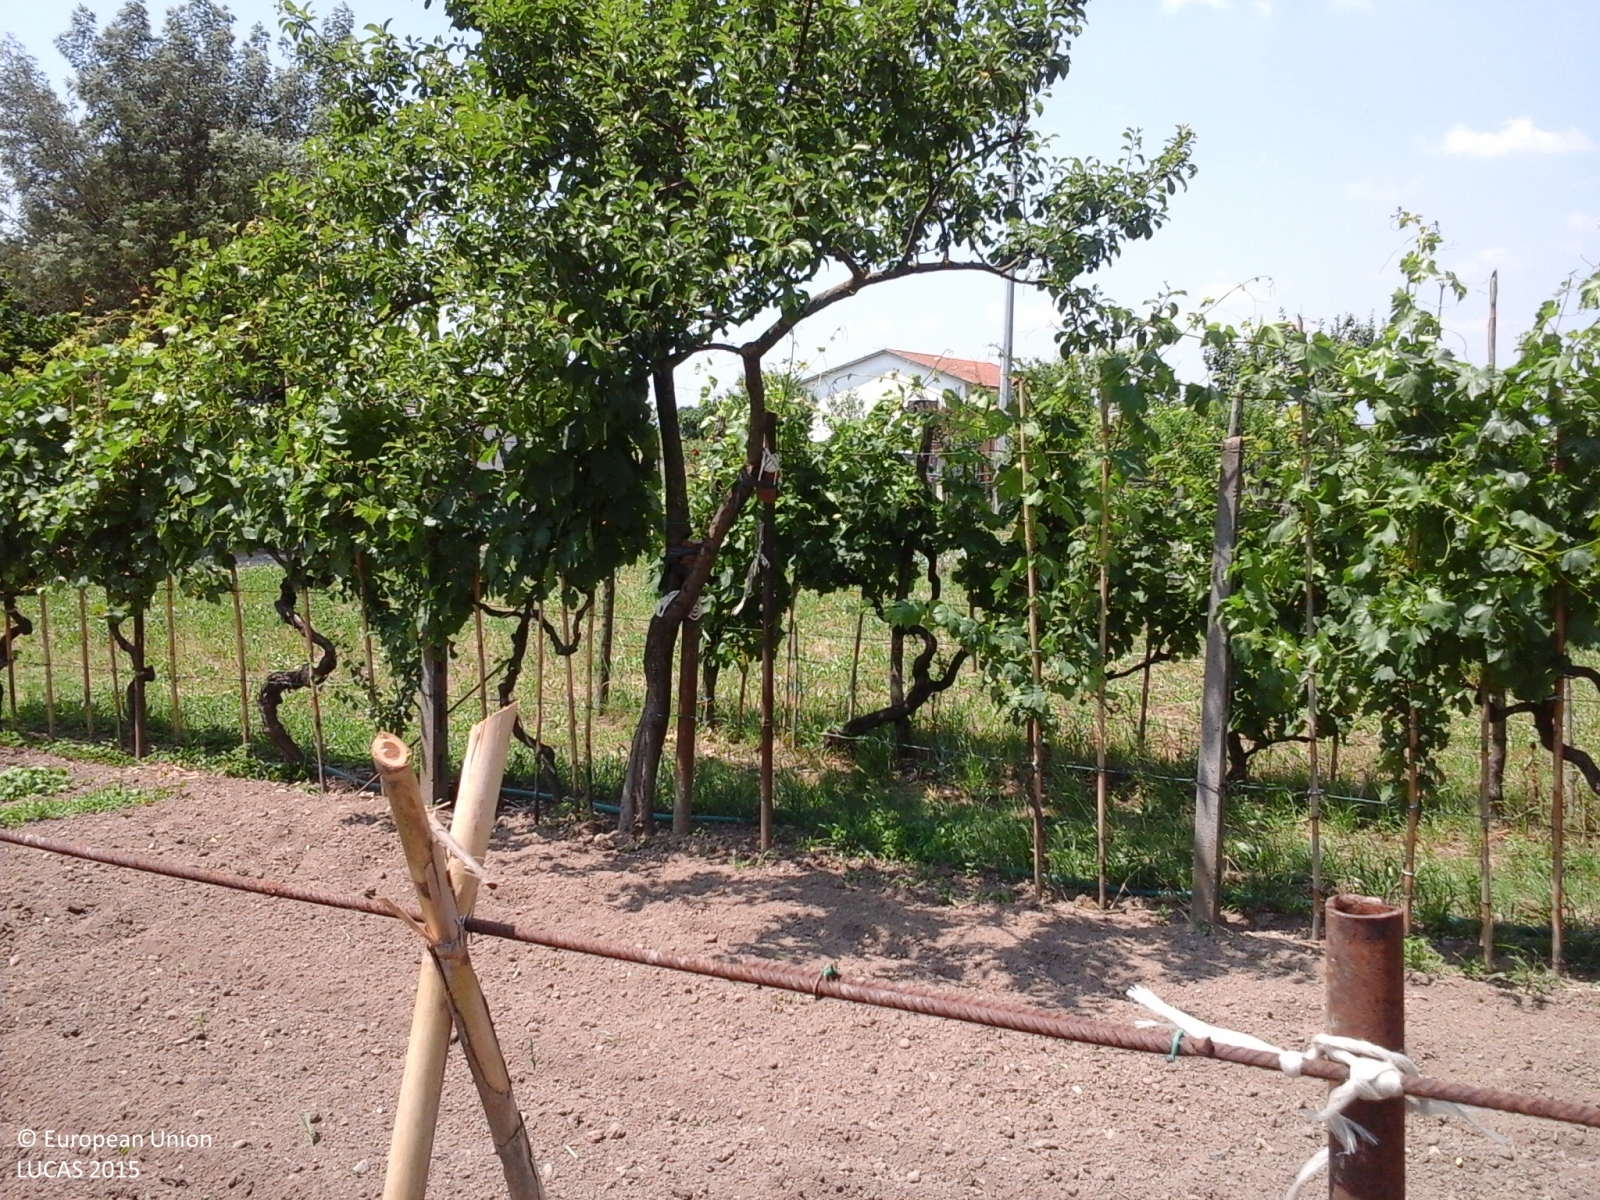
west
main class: Cropland
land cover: Other fresh vegetables
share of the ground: > 75 %
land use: Kitchen garden
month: June
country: IT
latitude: 43.8942
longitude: 11.0555
